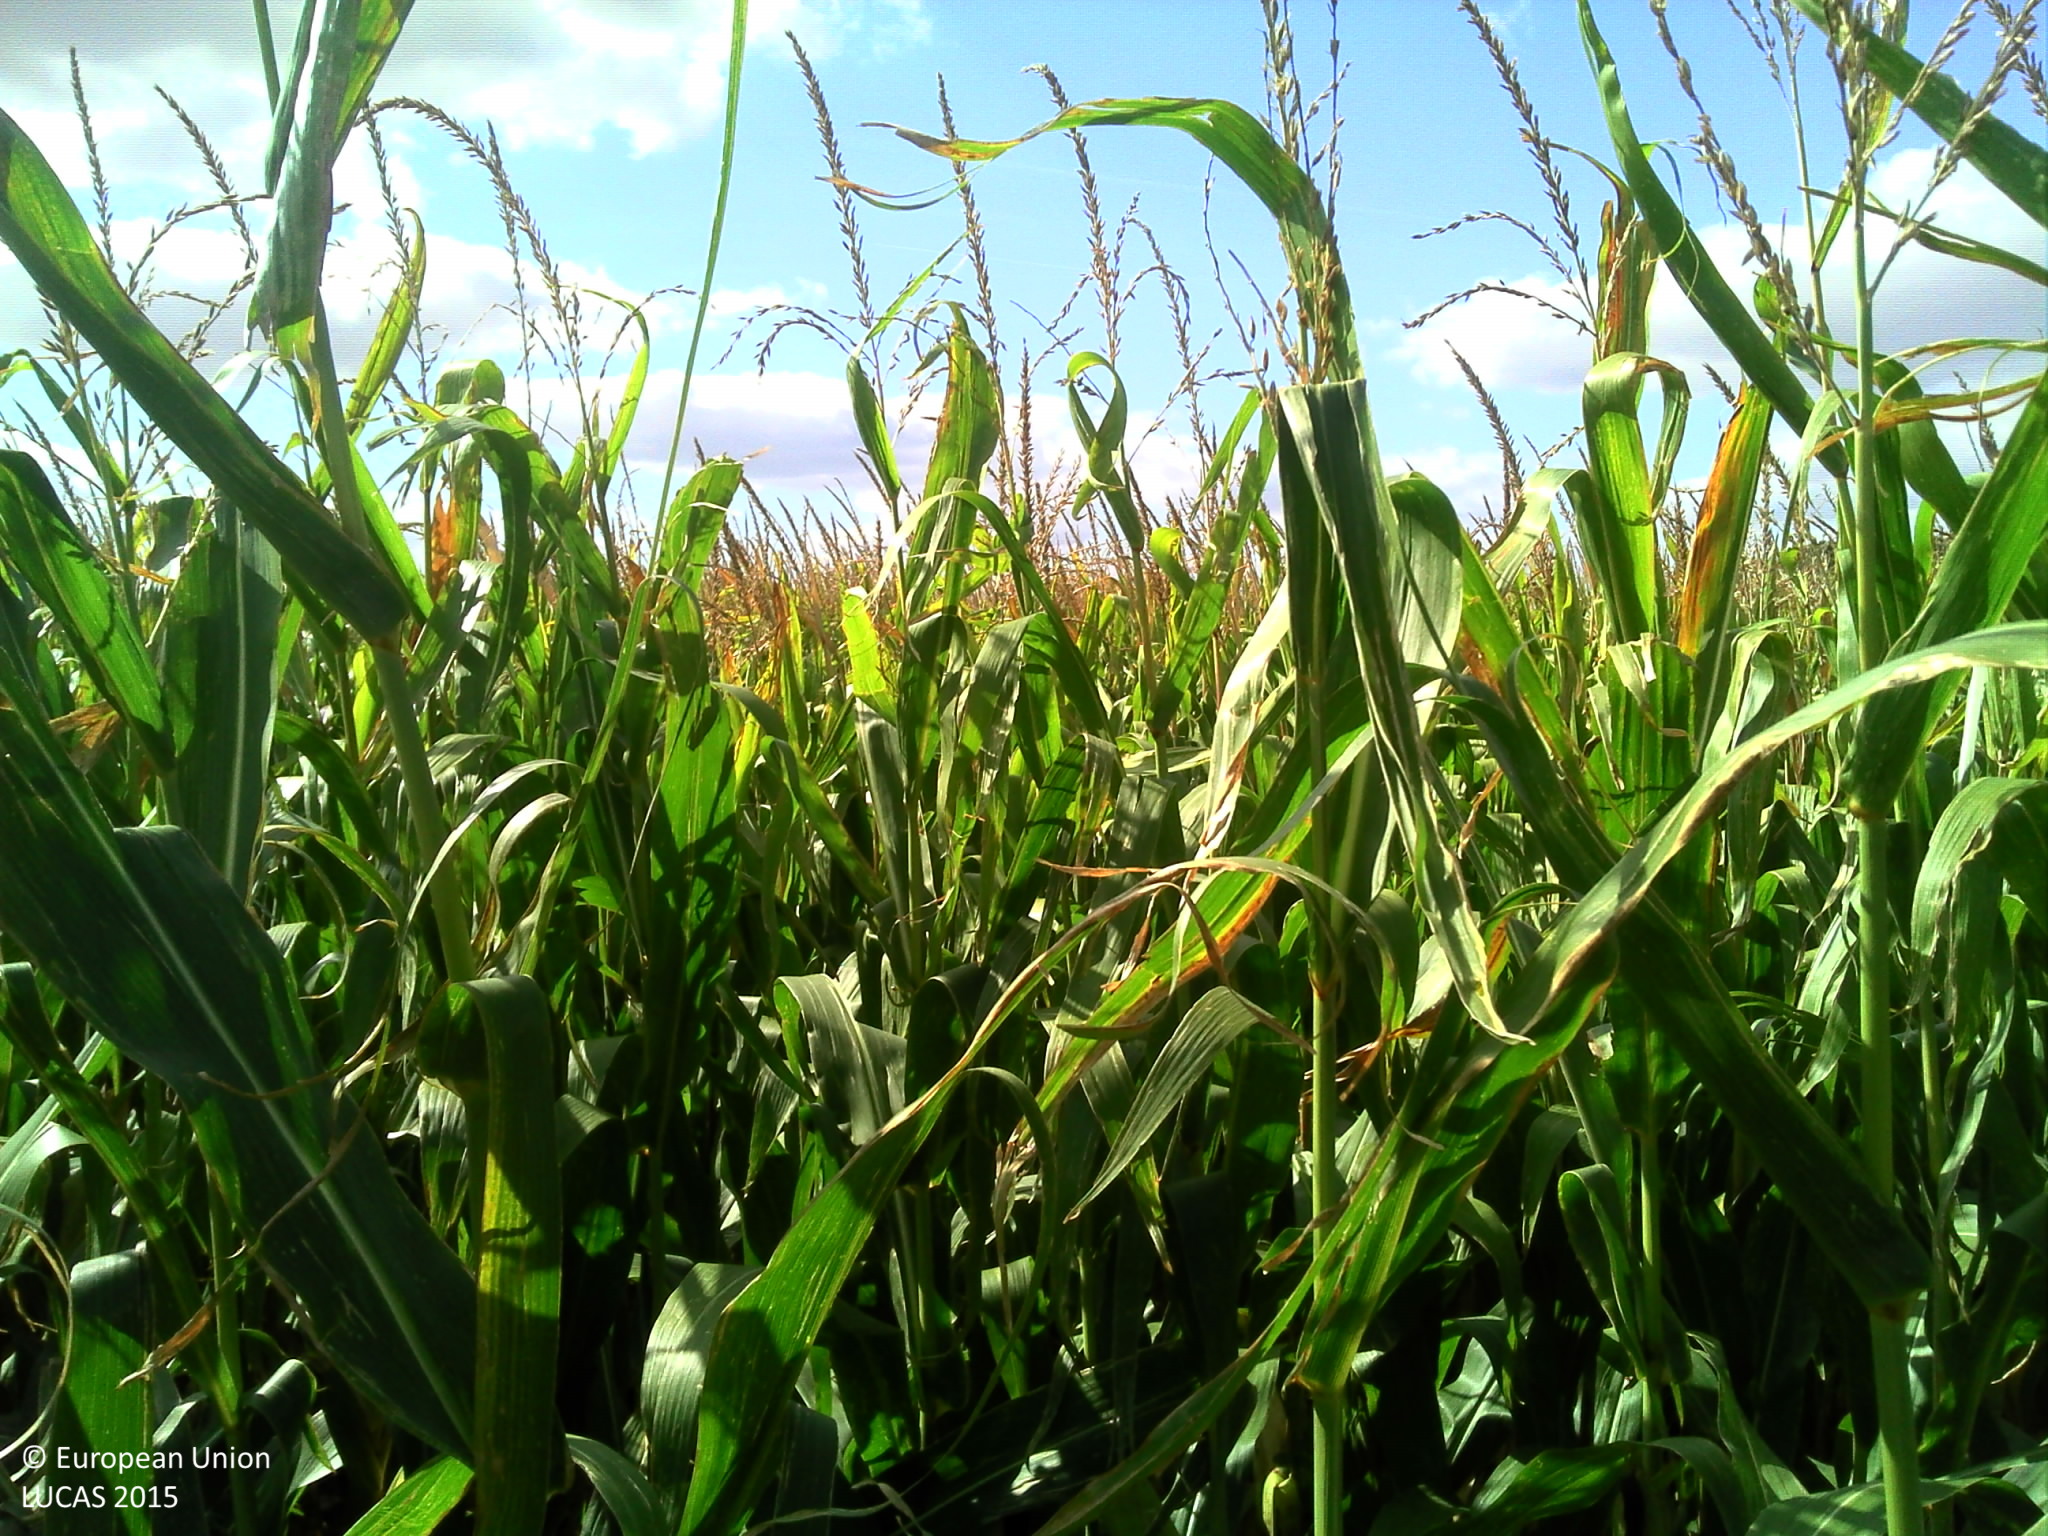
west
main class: Cropland
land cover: Maize
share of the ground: > 75 %
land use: Agriculture (excluding fallow land and kitchen gardens)
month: September
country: FR
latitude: 46.9272
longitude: 1.6230
